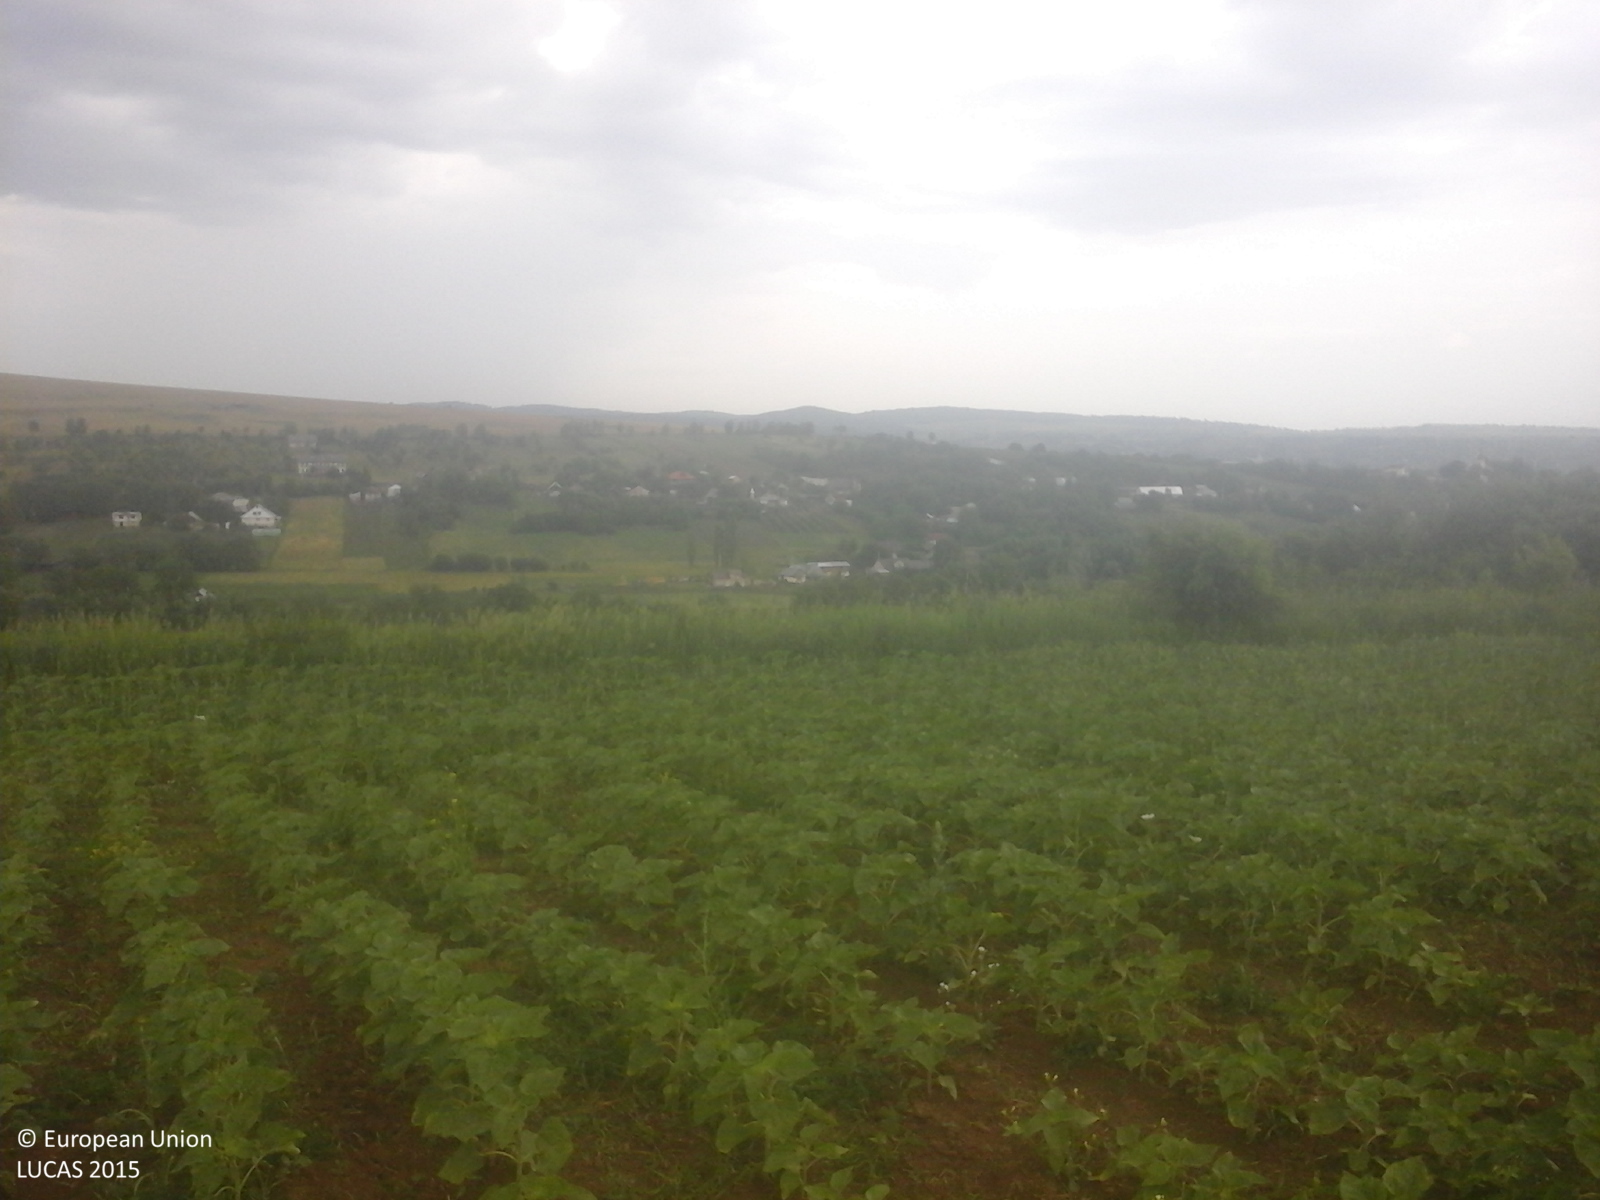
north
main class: Cropland
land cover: Sunflower
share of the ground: 25 - 50 %
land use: Agriculture (excluding fallow land and kitchen gardens)
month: June
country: RO
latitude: 47.0019
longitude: 26.4041
